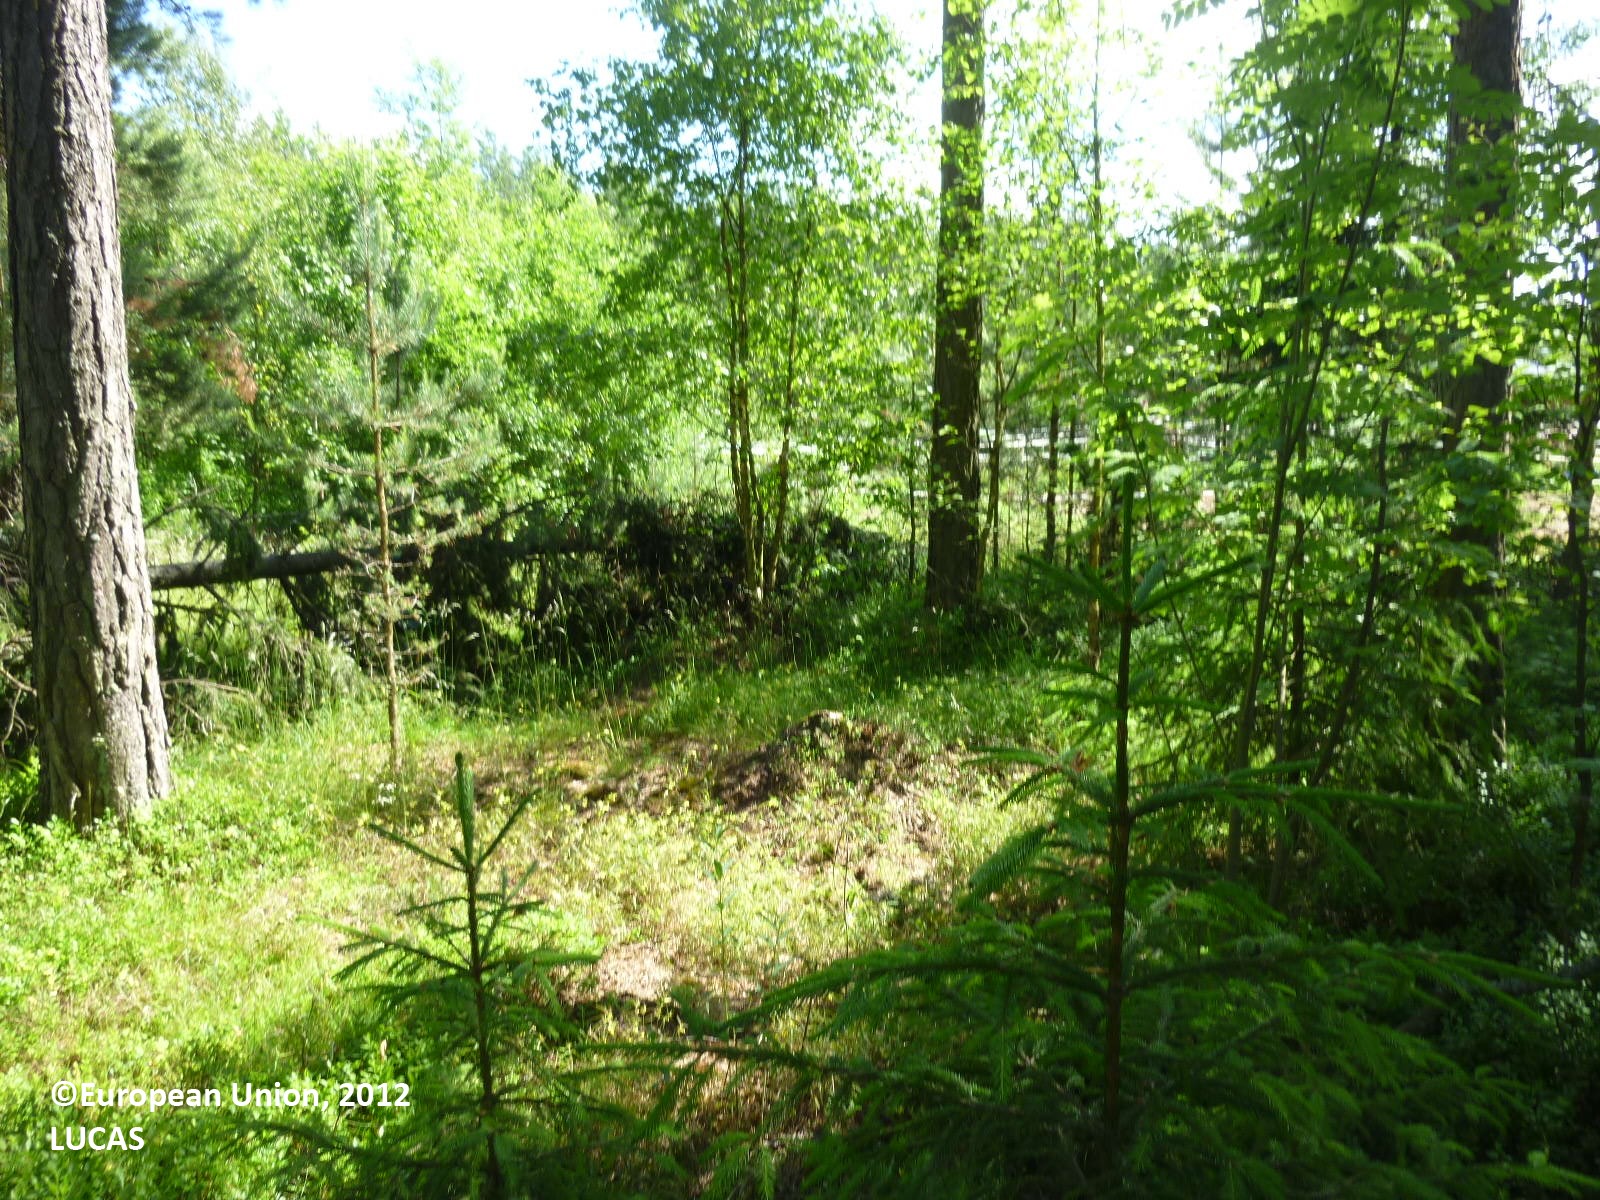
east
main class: Woodland
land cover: Other coniferous woodland
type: boreal forest
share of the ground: > 75 %
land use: Forestry
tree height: > 5 m
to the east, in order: Other coniferous woodland; Broadleaved woodland; Ditches and canals; Broadleaved woodland; Fences; Temporary grasslands; Fences; Grass margins; Electric lines; Grass margins; Broadleaved woodland; Ditches and canals; Shrubland without tree cover; Paved roads, cycling and walking lanes; Shrubland without tree cover; Ditches and canals; Pine dominated coniferous woodland; Fences; Pine dominated coniferous woodland; Fences; Pine dominated coniferous woodland; Fences; Pine dominated coniferous woodland; Tracks; Broadleaved woodland
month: July
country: FI
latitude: 61.3533
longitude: 22.1199
